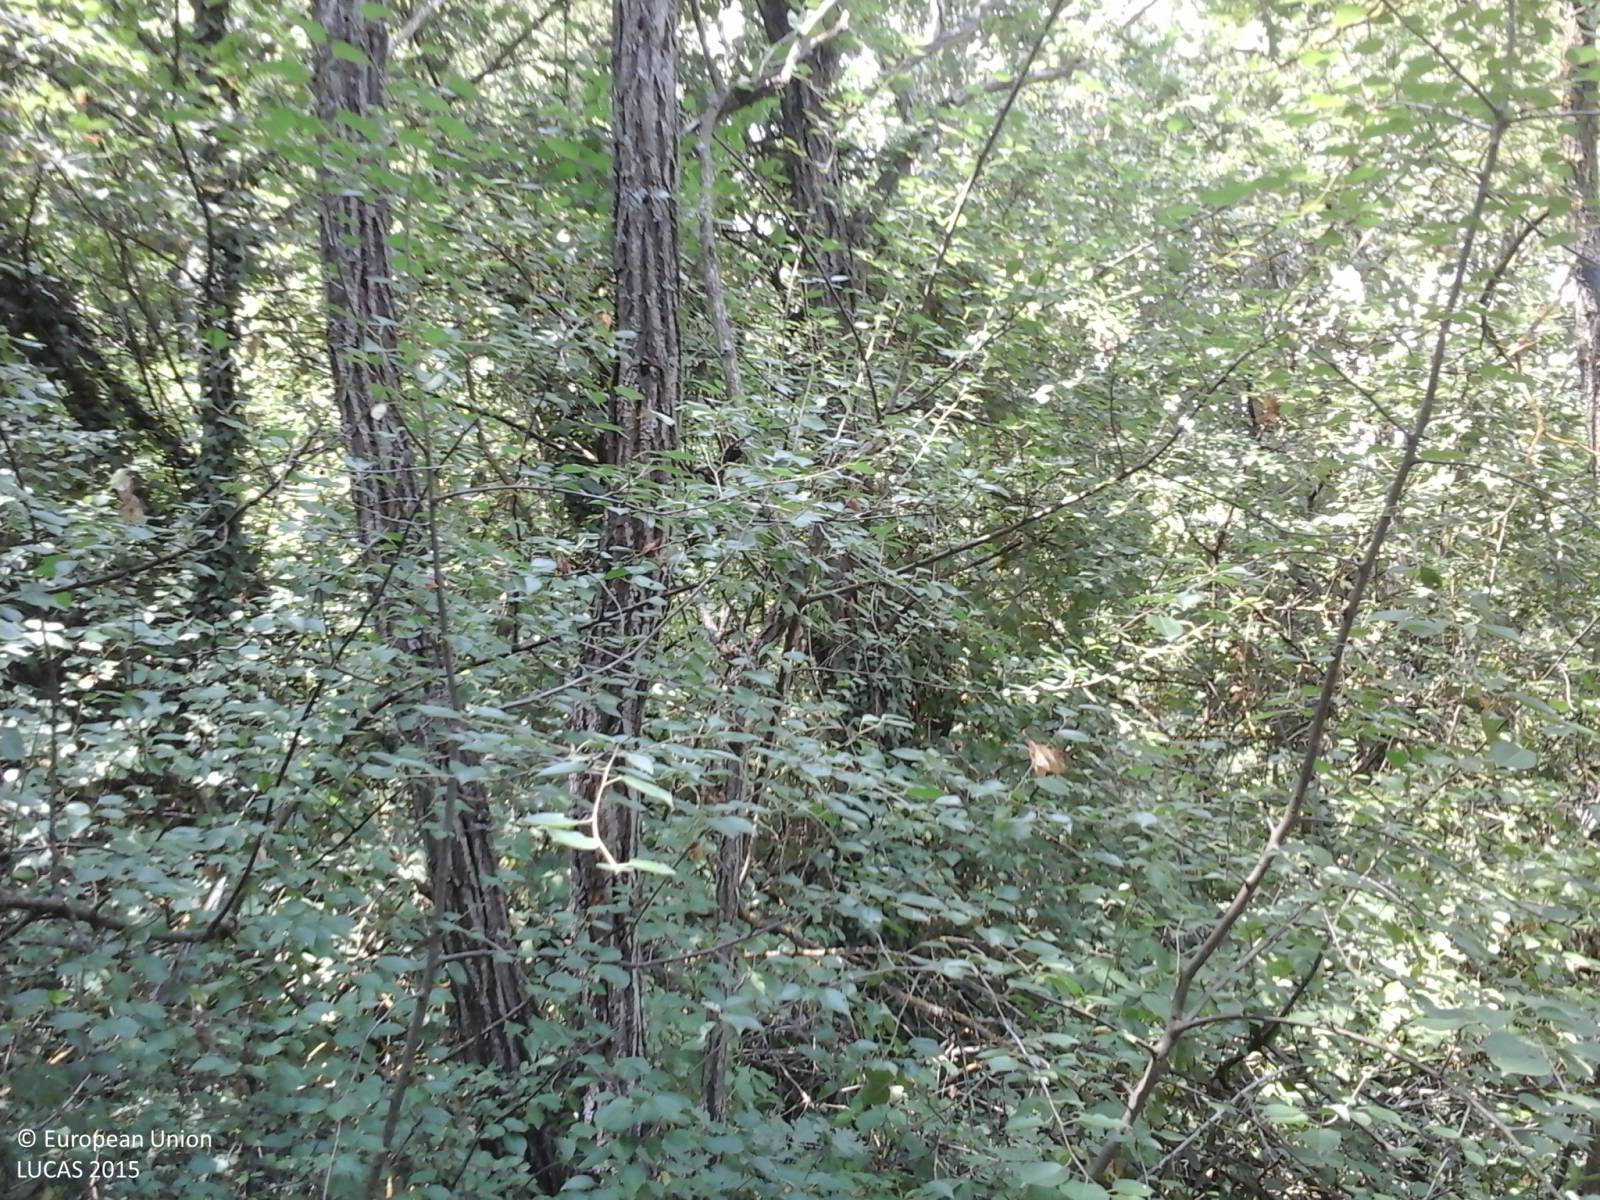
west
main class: Woodland
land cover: Broadleaved woodland
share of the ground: > 75 %
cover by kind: broadleaved forest trees 100 %
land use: Semi-natural and natural areas not in use
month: July
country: IT
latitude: 42.3258
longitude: 13.3989
